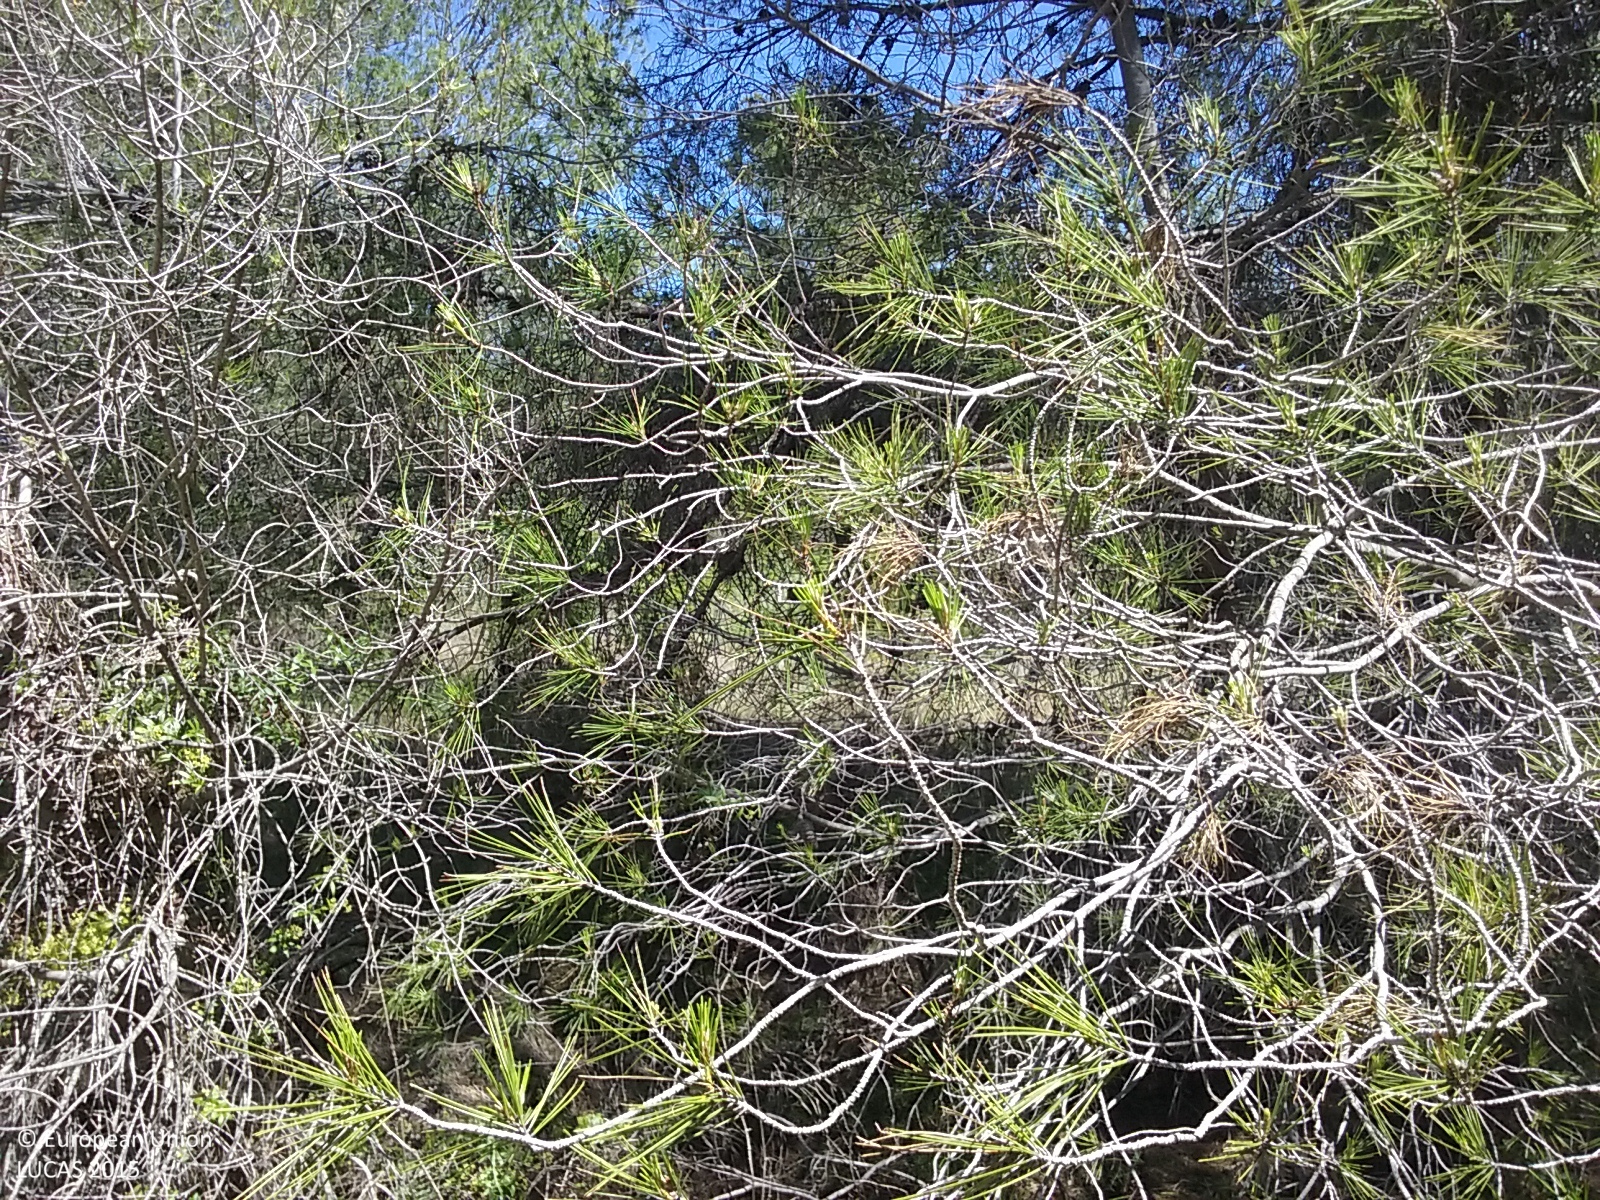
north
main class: Woodland
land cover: Pine dominated coniferous woodland
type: coniferous forest of the mediterranean region
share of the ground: 50 - 75 %
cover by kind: coniferous forest trees 50 %, shrubs 50 %
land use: Forestry
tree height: > 5 m
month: May
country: ES
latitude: 40.2993
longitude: 0.3387
